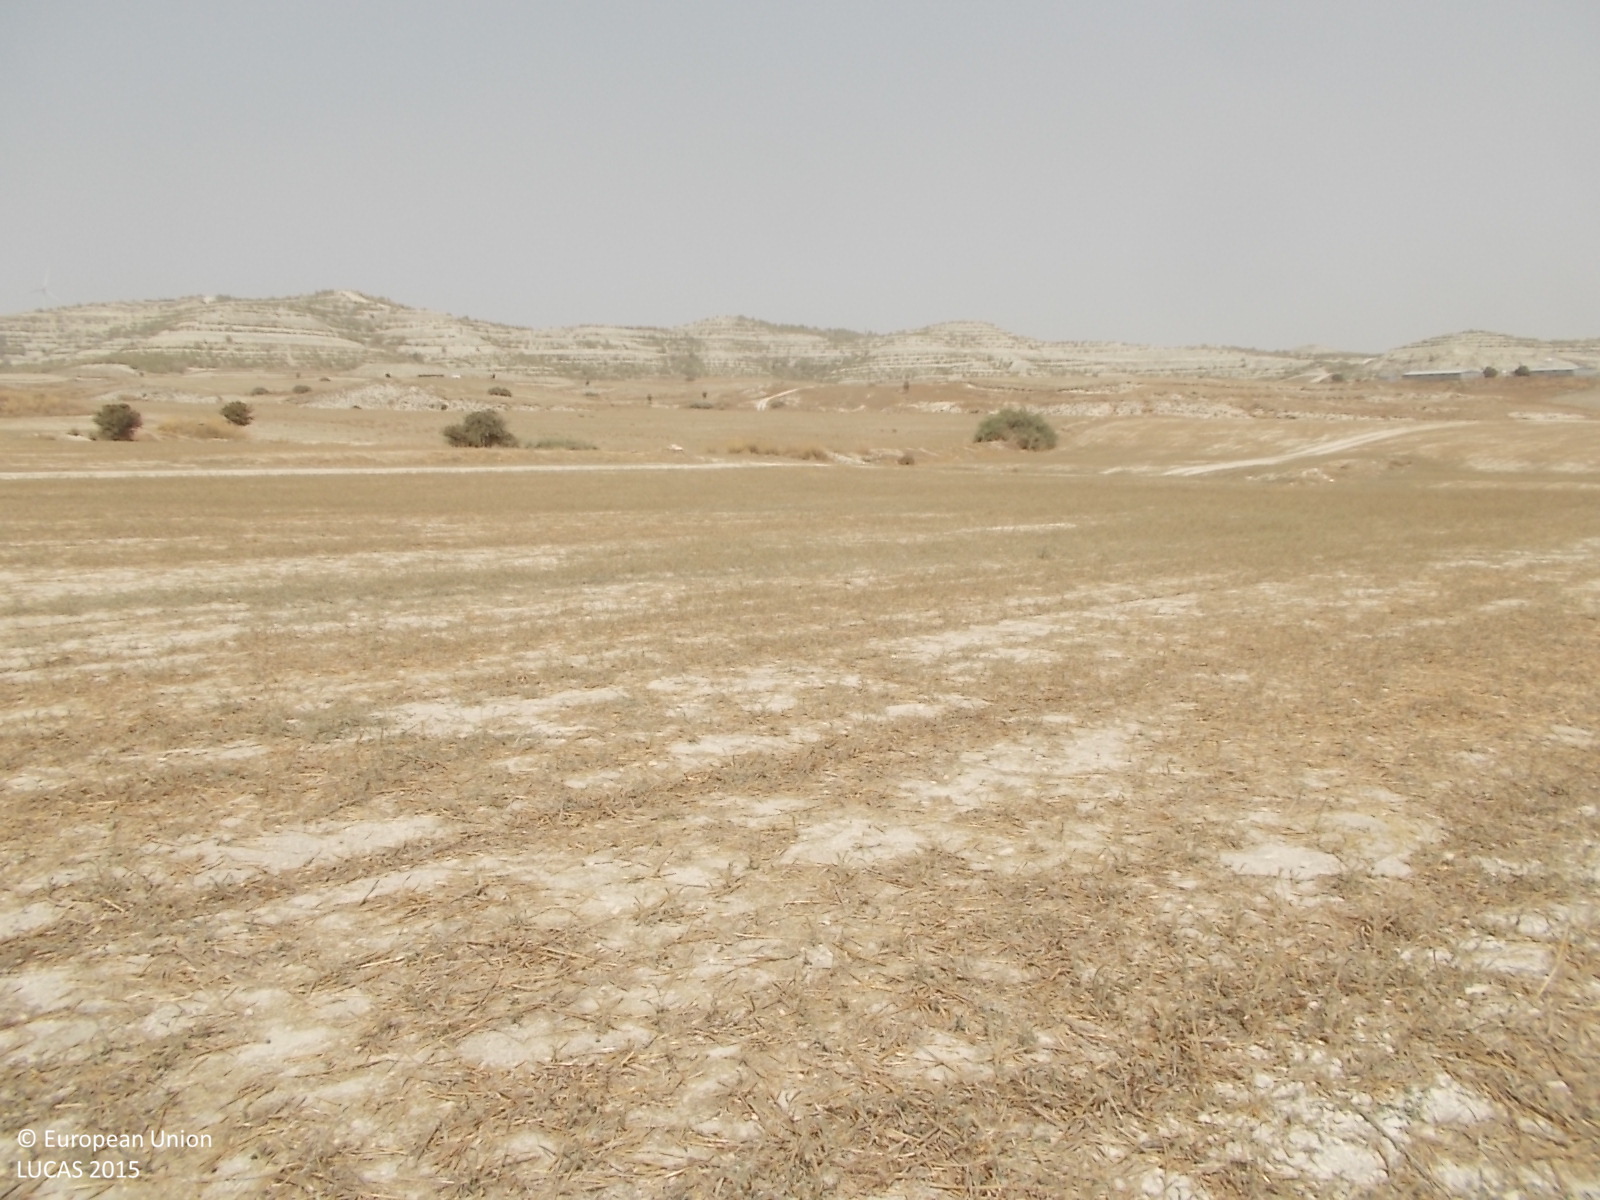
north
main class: Cropland
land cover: Mixed cereals for fodder
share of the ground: > 75 %
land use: Agriculture (excluding fallow land and kitchen gardens)
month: April
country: CY
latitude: 34.9398
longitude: 33.5247
